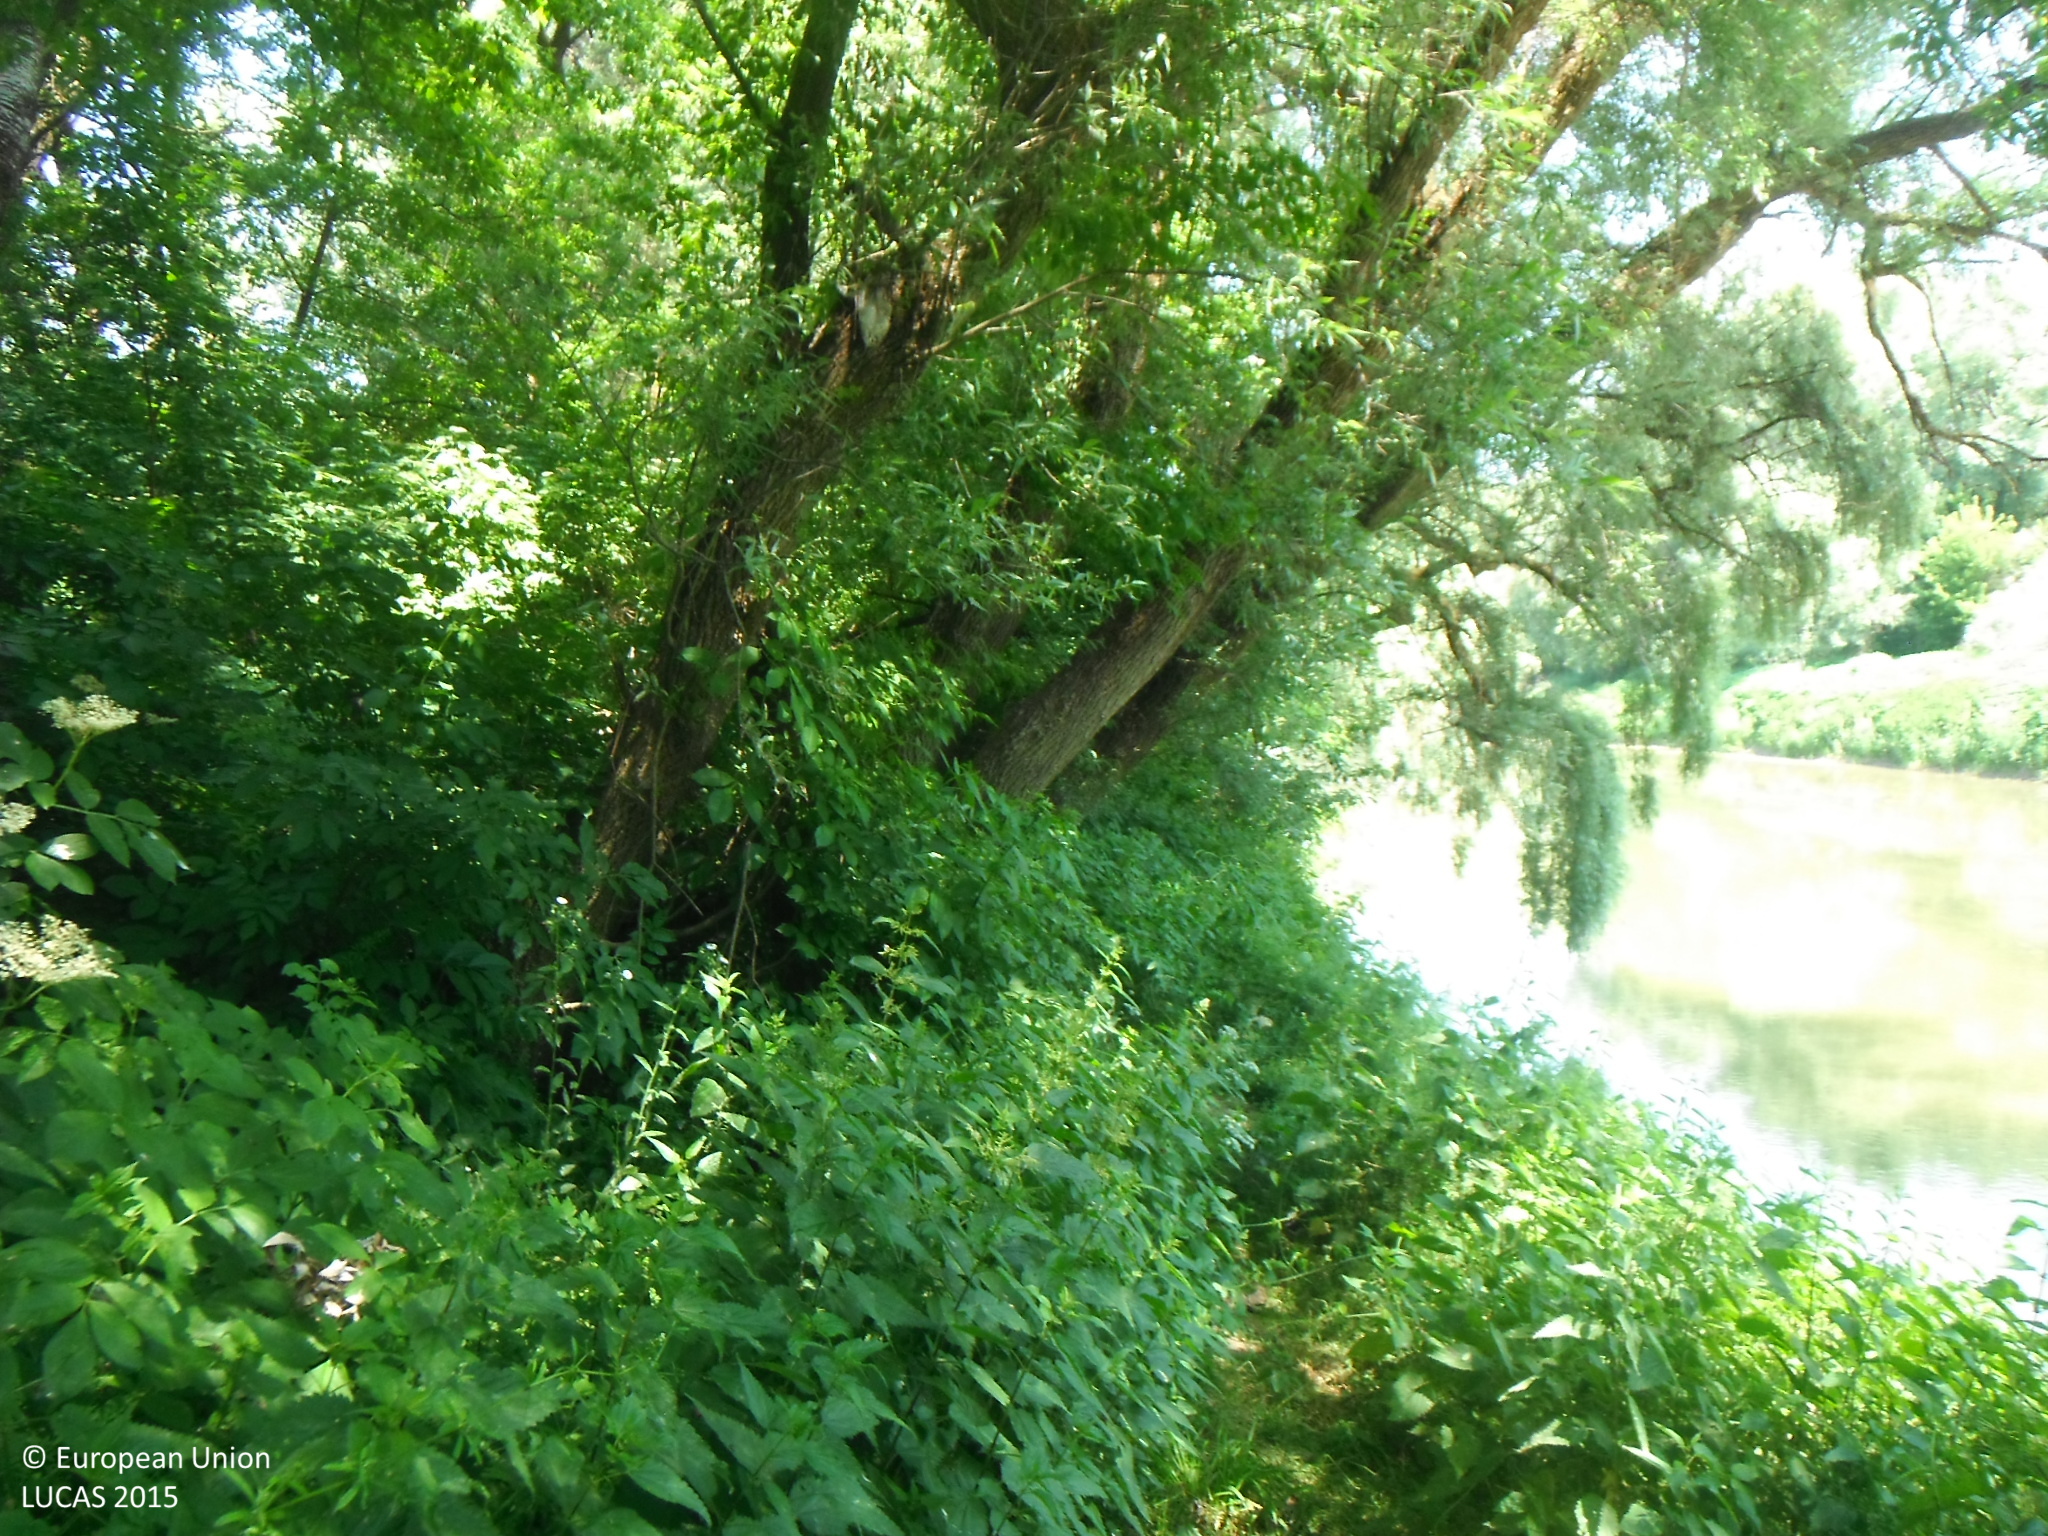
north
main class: Grassland
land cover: Spontaneously vegetated surfaces
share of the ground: > 75 %
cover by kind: herbaceous plants 95 %, shrubs 5 %
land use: Semi-natural and natural areas not in use
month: June
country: SK
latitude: 48.7966
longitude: 21.8833
